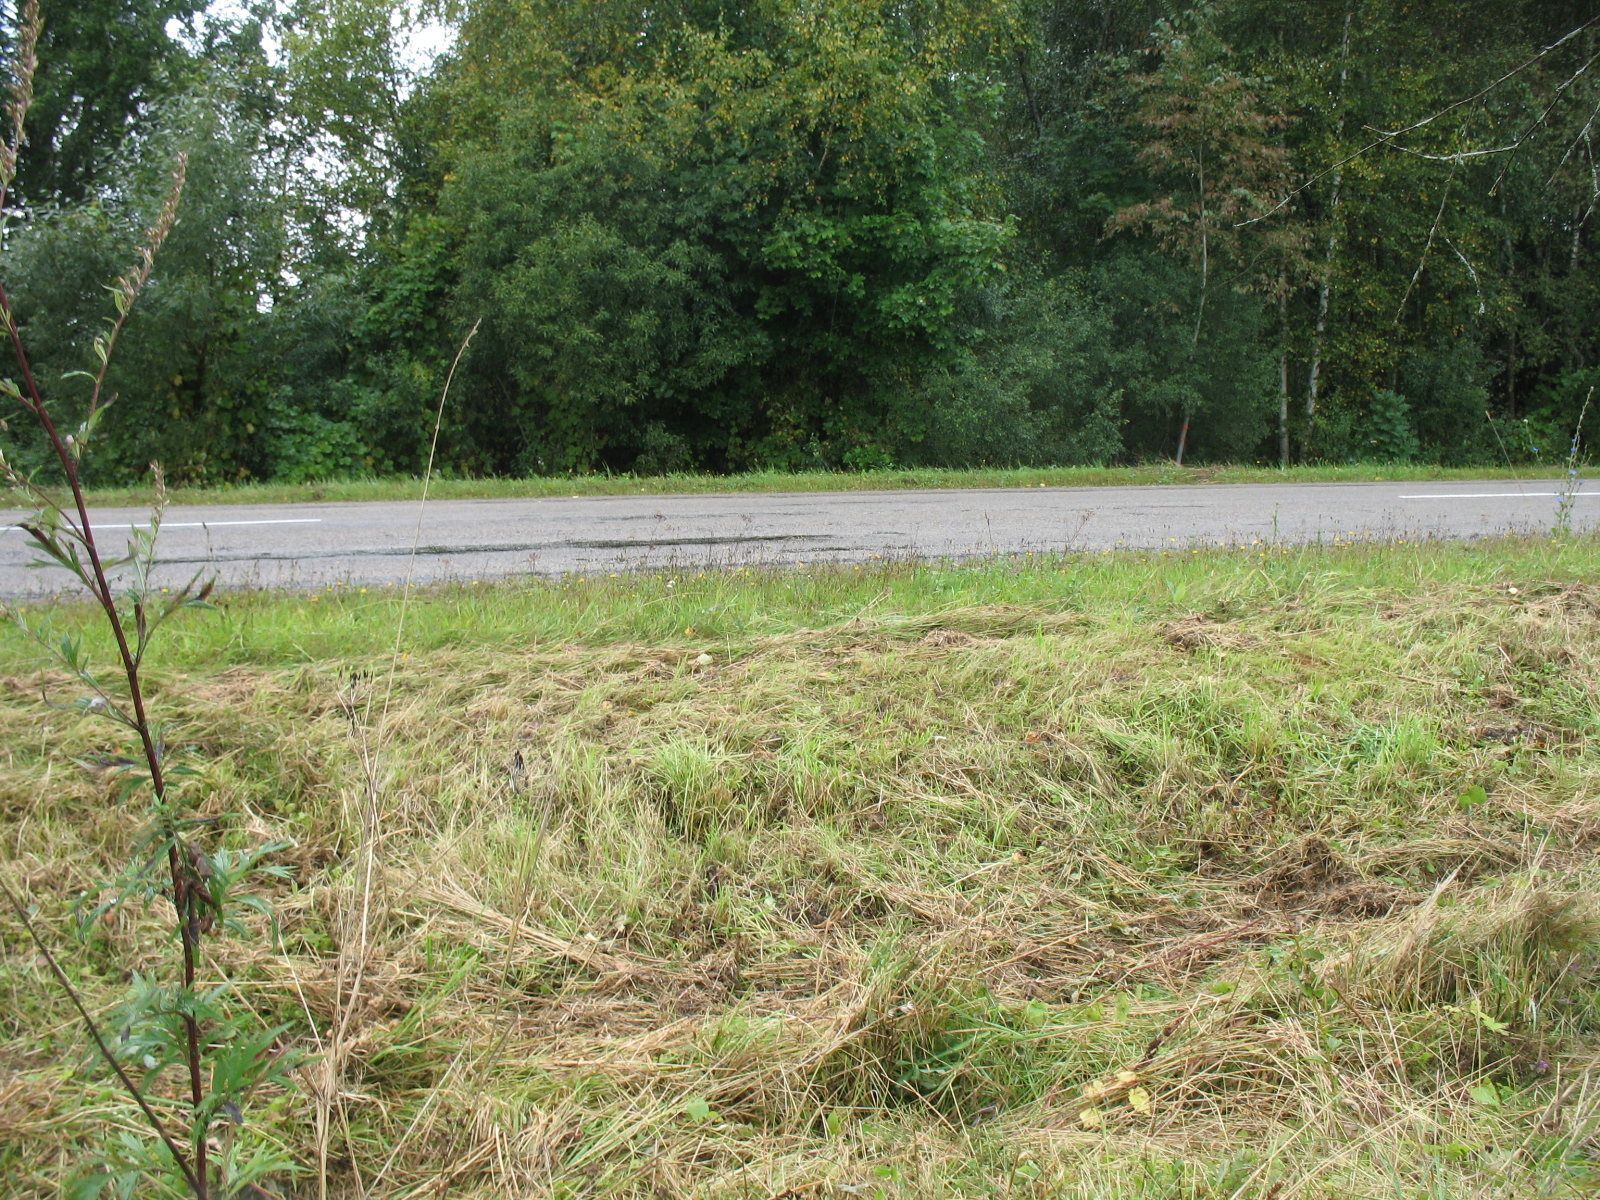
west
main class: Grassland
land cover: Grassland with sparse tree/shrub cover
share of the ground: > 75 %
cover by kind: herbaceous plants 95 %, broadleaved forest trees 5 %
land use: Agriculture (excluding fallow land and kitchen gardens)
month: September
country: LV
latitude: 56.0698
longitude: 25.8910
